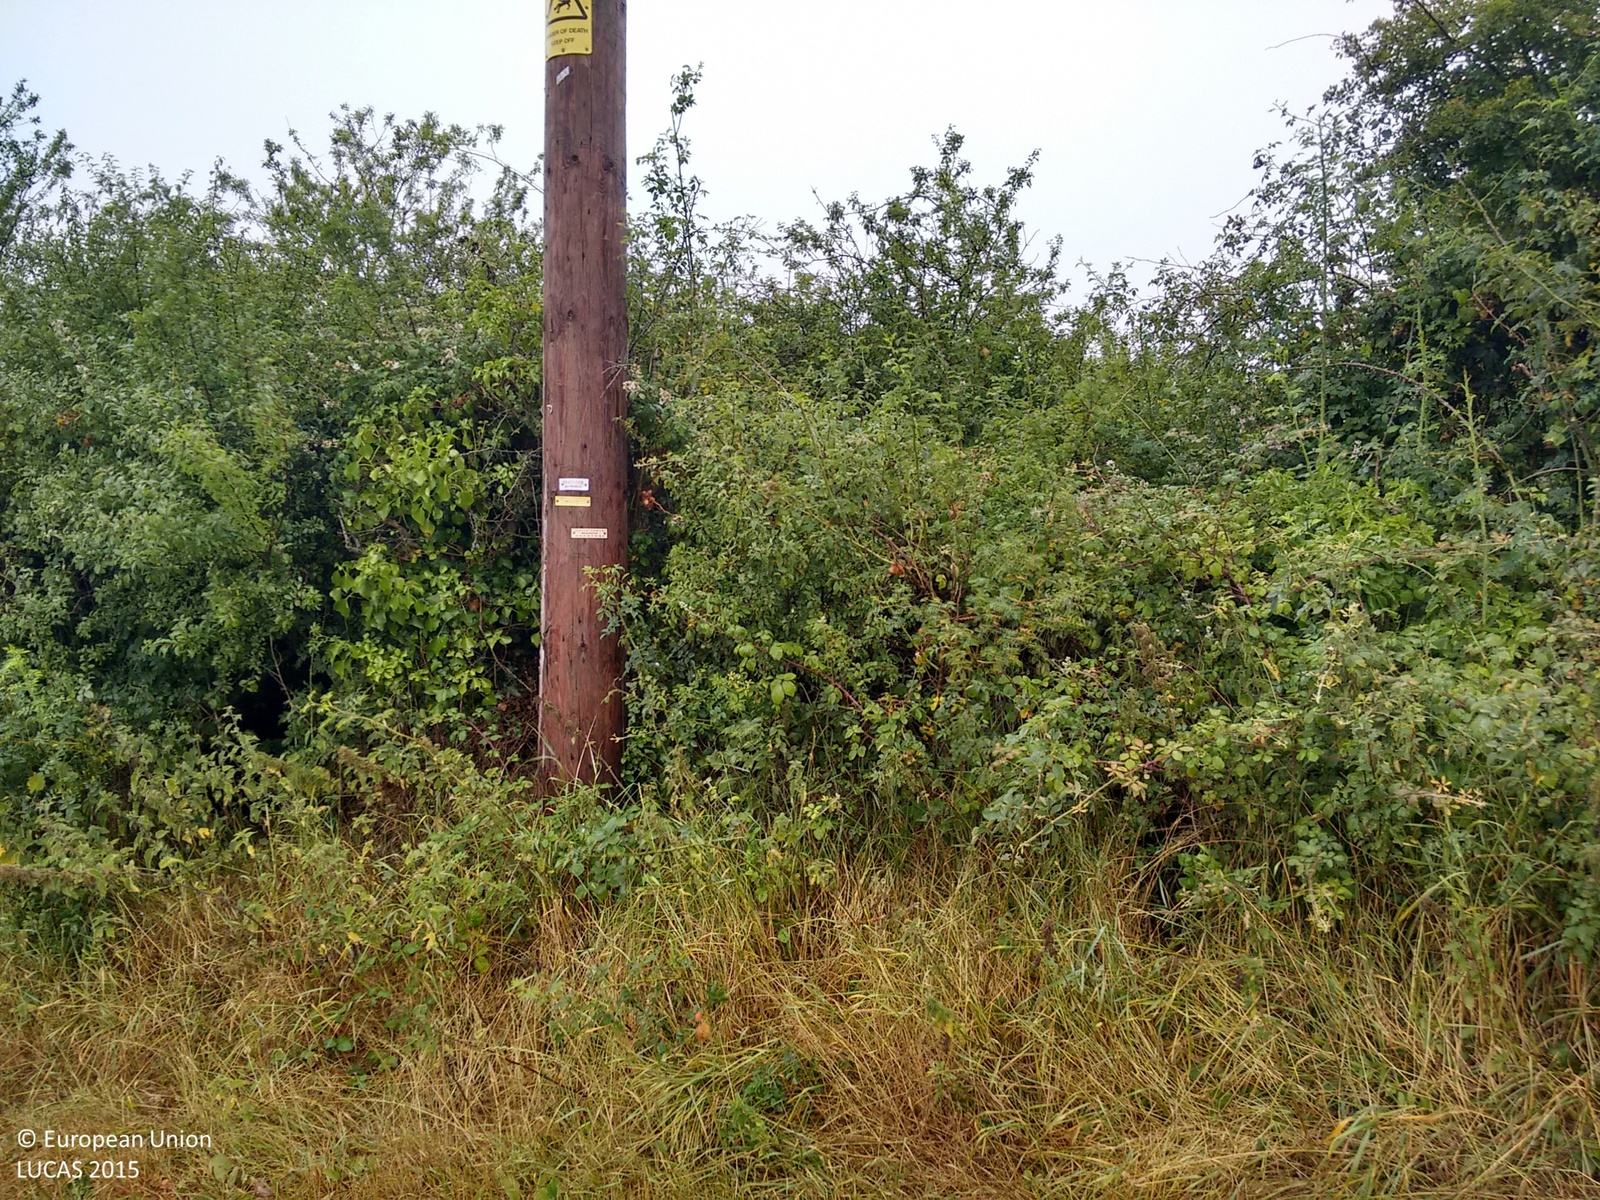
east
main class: Cropland
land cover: Rape and turnip rape
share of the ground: > 75 %
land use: Agriculture (excluding fallow land and kitchen gardens)
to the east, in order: Rape and turnip rape; Grass margins; Fences; Tracks; Electric lines; Tracks; Shrubland with sparse tree cover; Grassland without tree/shrub cover; Broadleaved woodland; Fences; Grassland without tree/shrub cover
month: July
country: GB
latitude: 50.7468
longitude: -2.3512
